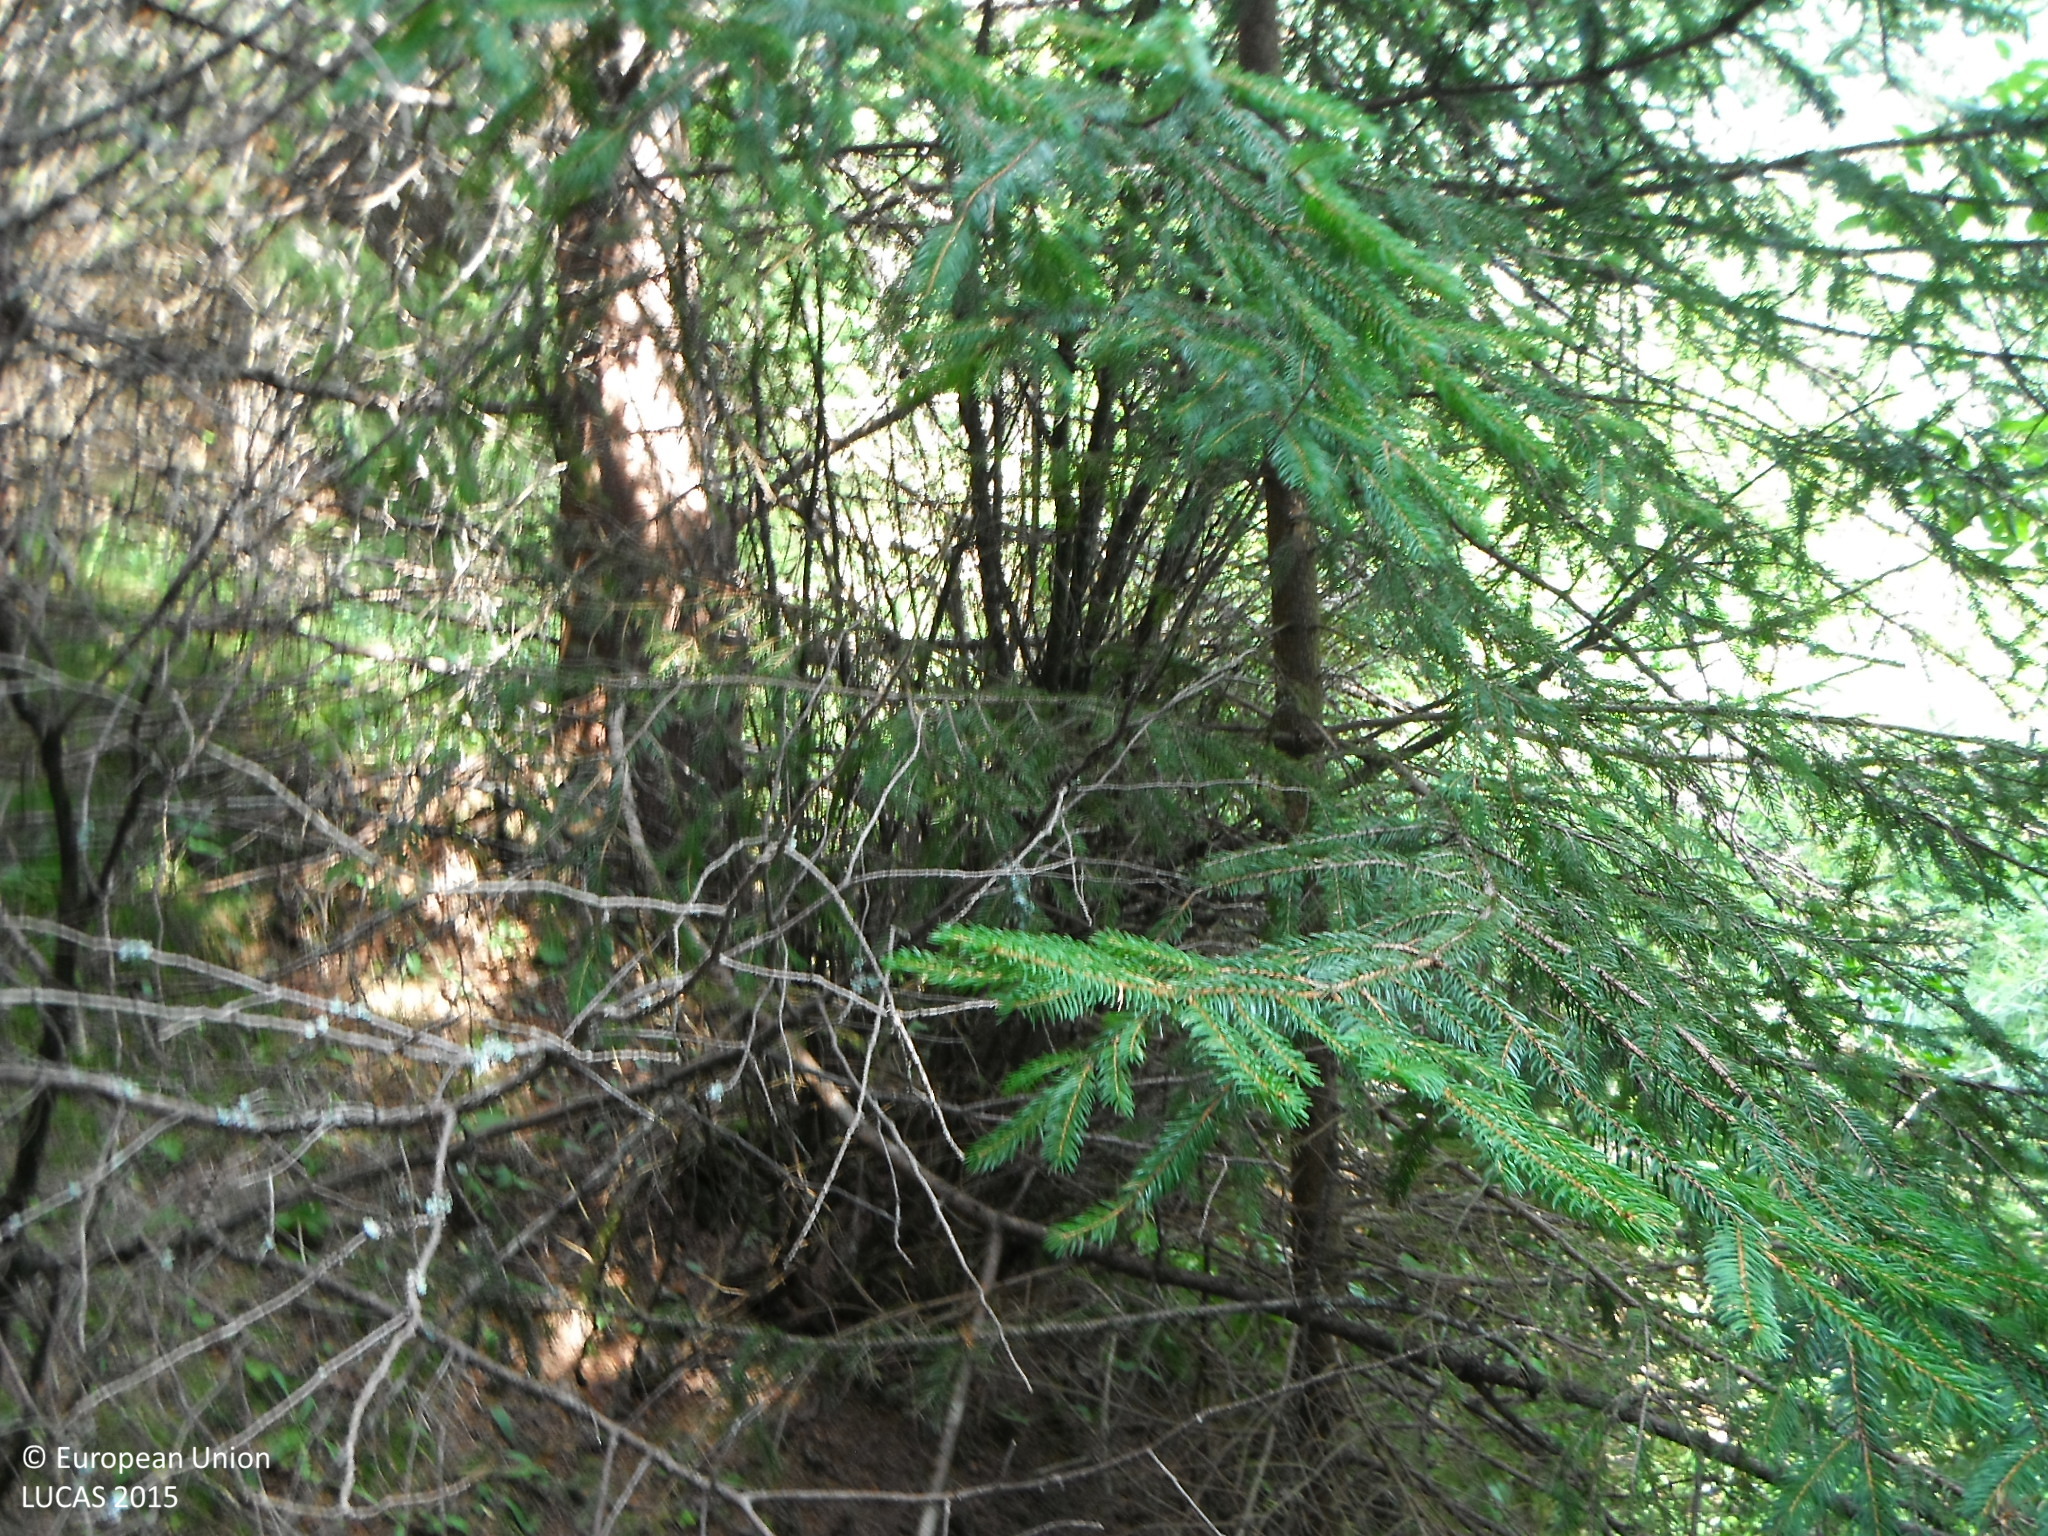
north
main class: Woodland
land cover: Spruce dominated coniferous woodland
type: alpine coniferous forest
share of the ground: > 75 %
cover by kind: coniferous forest trees 100 %
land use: Forestry
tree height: > 5 m
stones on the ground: > 50 %
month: August
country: SK
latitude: 48.8413
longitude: 20.1558
